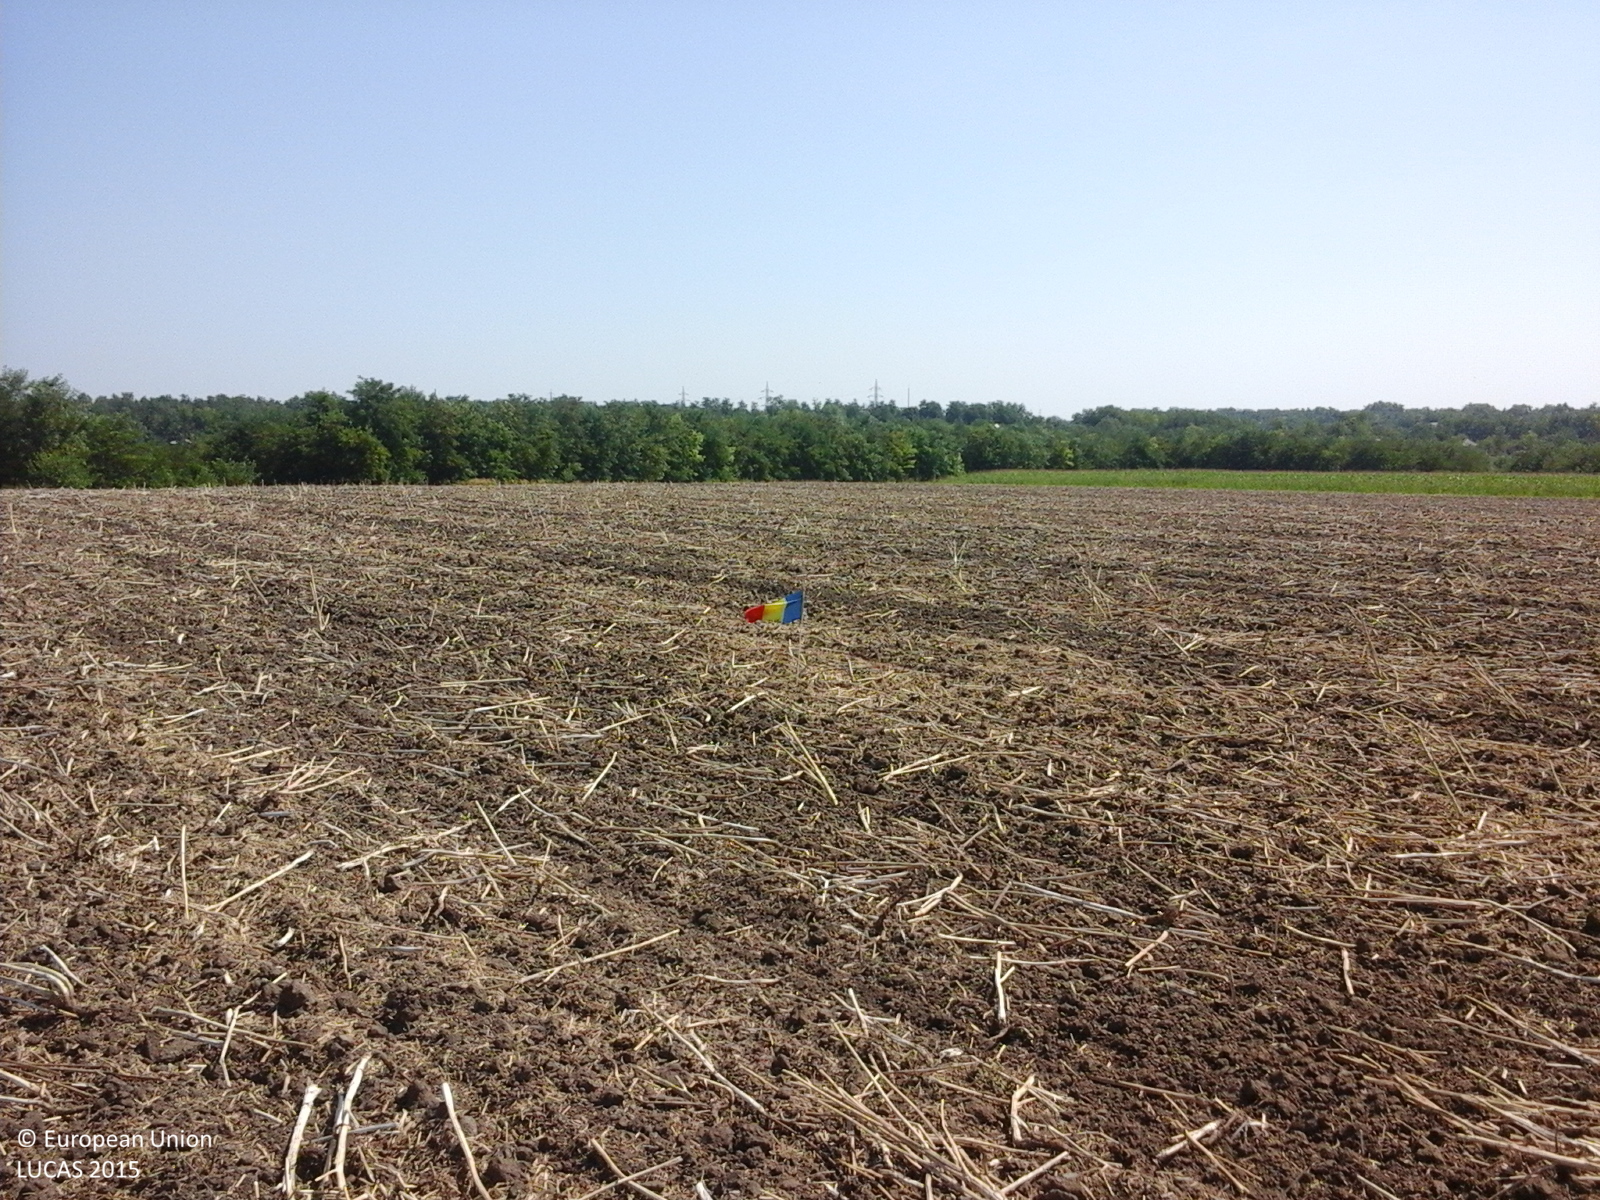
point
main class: Cropland
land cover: Rape and turnip rape
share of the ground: < 10 %
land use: Agriculture (excluding fallow land and kitchen gardens)
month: July
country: RO
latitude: 44.3397
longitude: 27.0743
